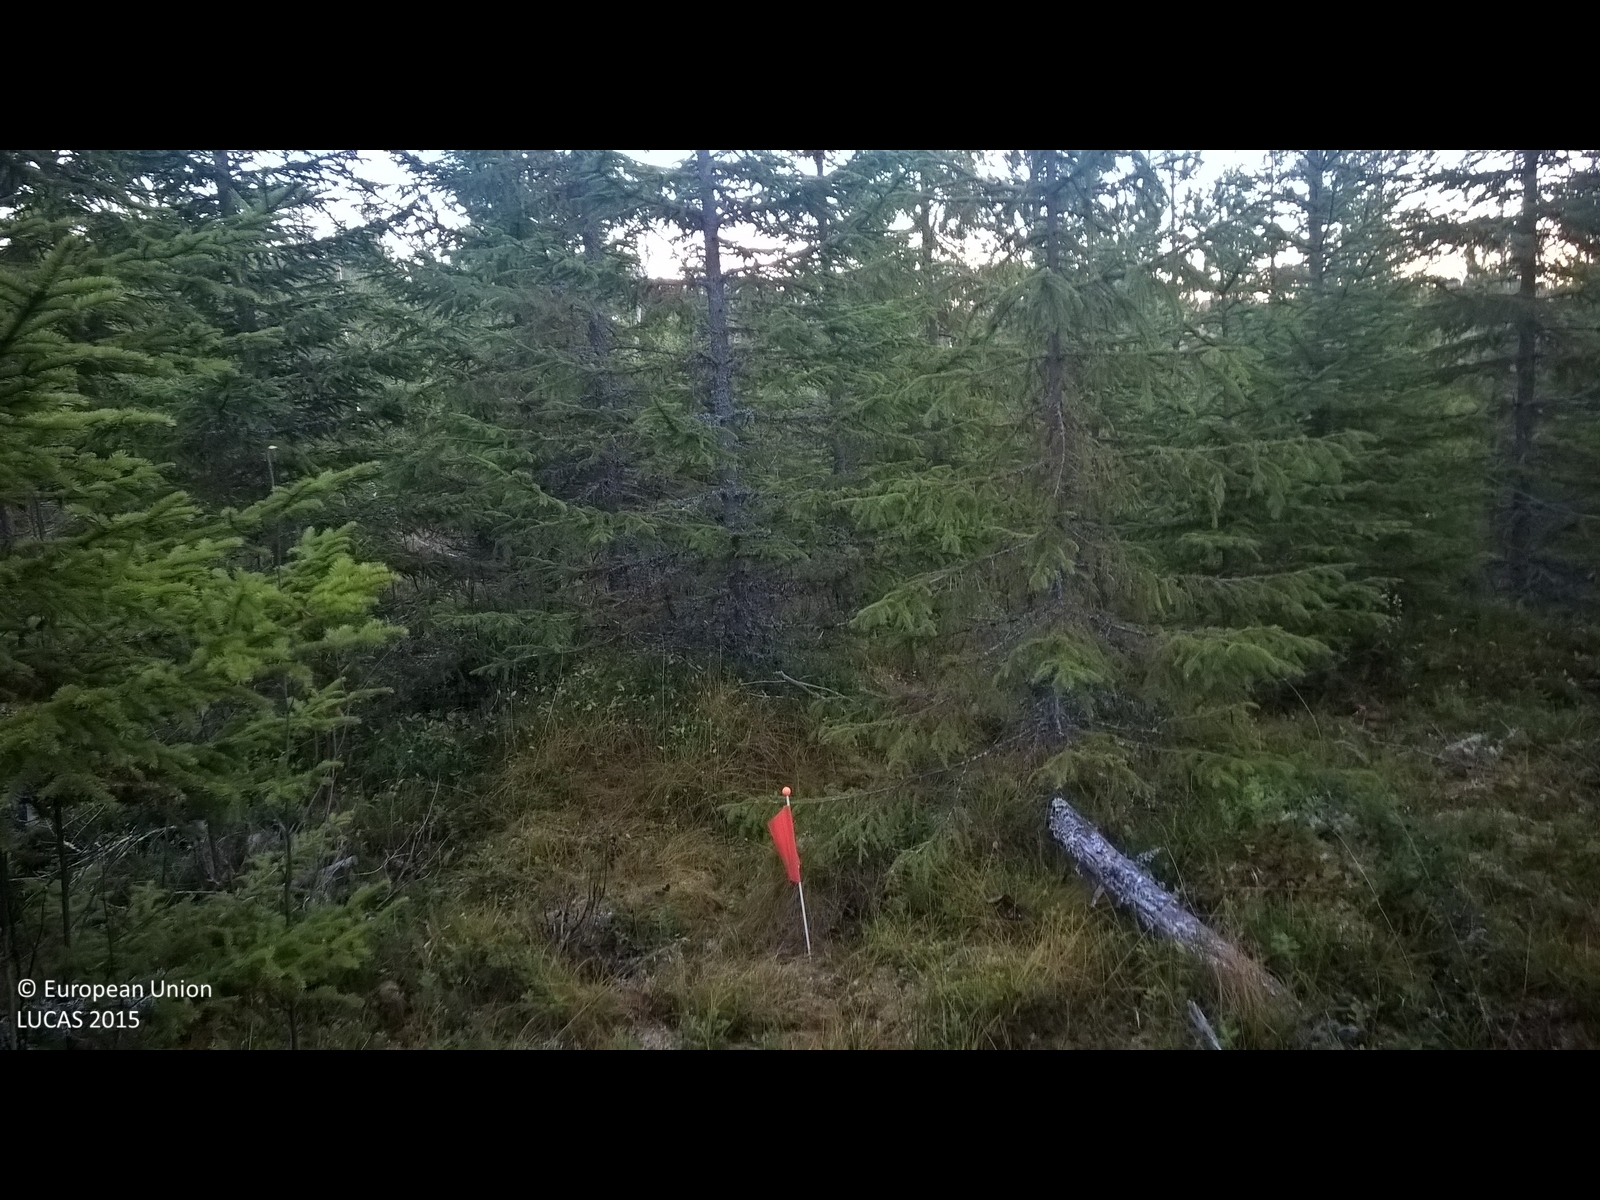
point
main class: Woodland
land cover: Spruce dominated coniferous woodland
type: boreal forest
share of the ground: 50 - 75 %
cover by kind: coniferous forest trees 70 %, lichens and mosses 30 %
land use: Forestry
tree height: > 5 m
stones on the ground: < 10 %
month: October
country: SE
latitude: 62.9575
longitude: 15.6751
